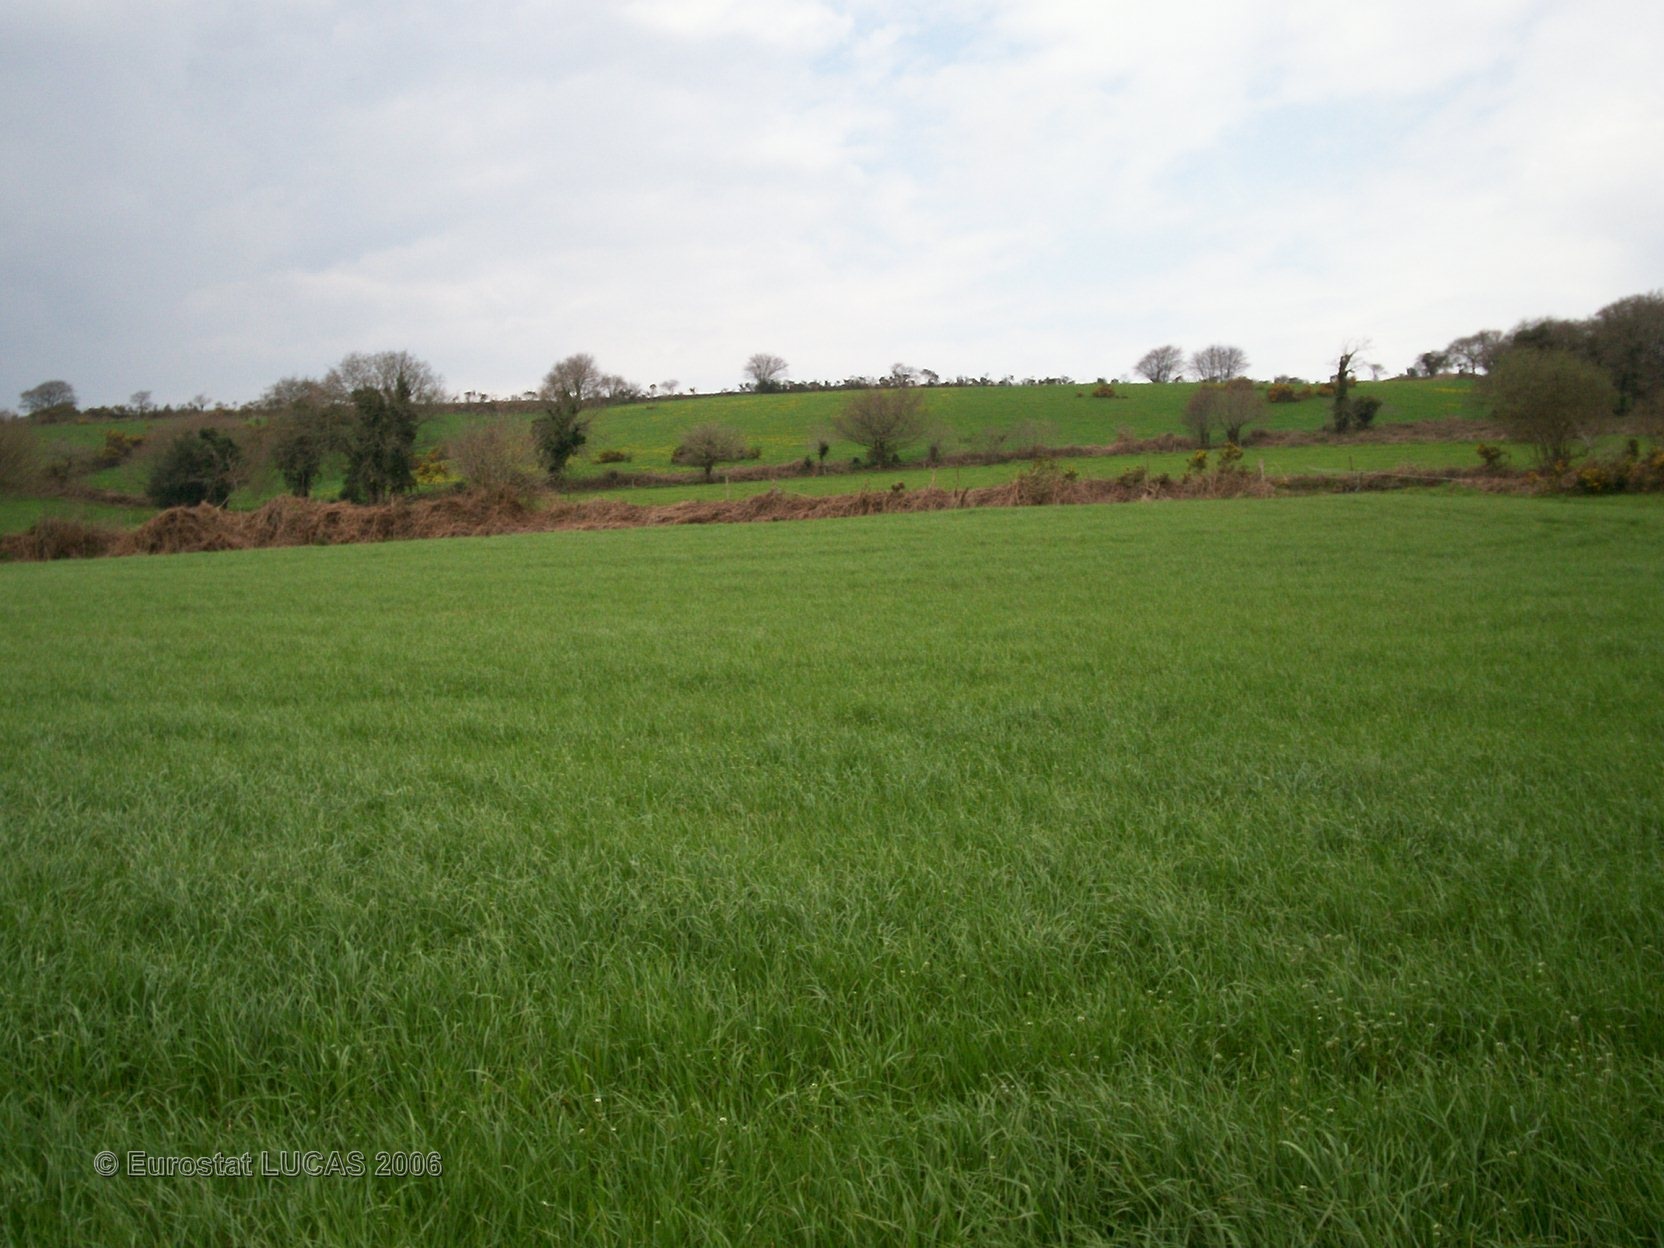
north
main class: Grassland
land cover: Grassland without tree/shrub cover
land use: Agriculture (excluding fallow land and kitchen gardens)
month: April
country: FR
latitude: 48.4791
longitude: -3.6780
